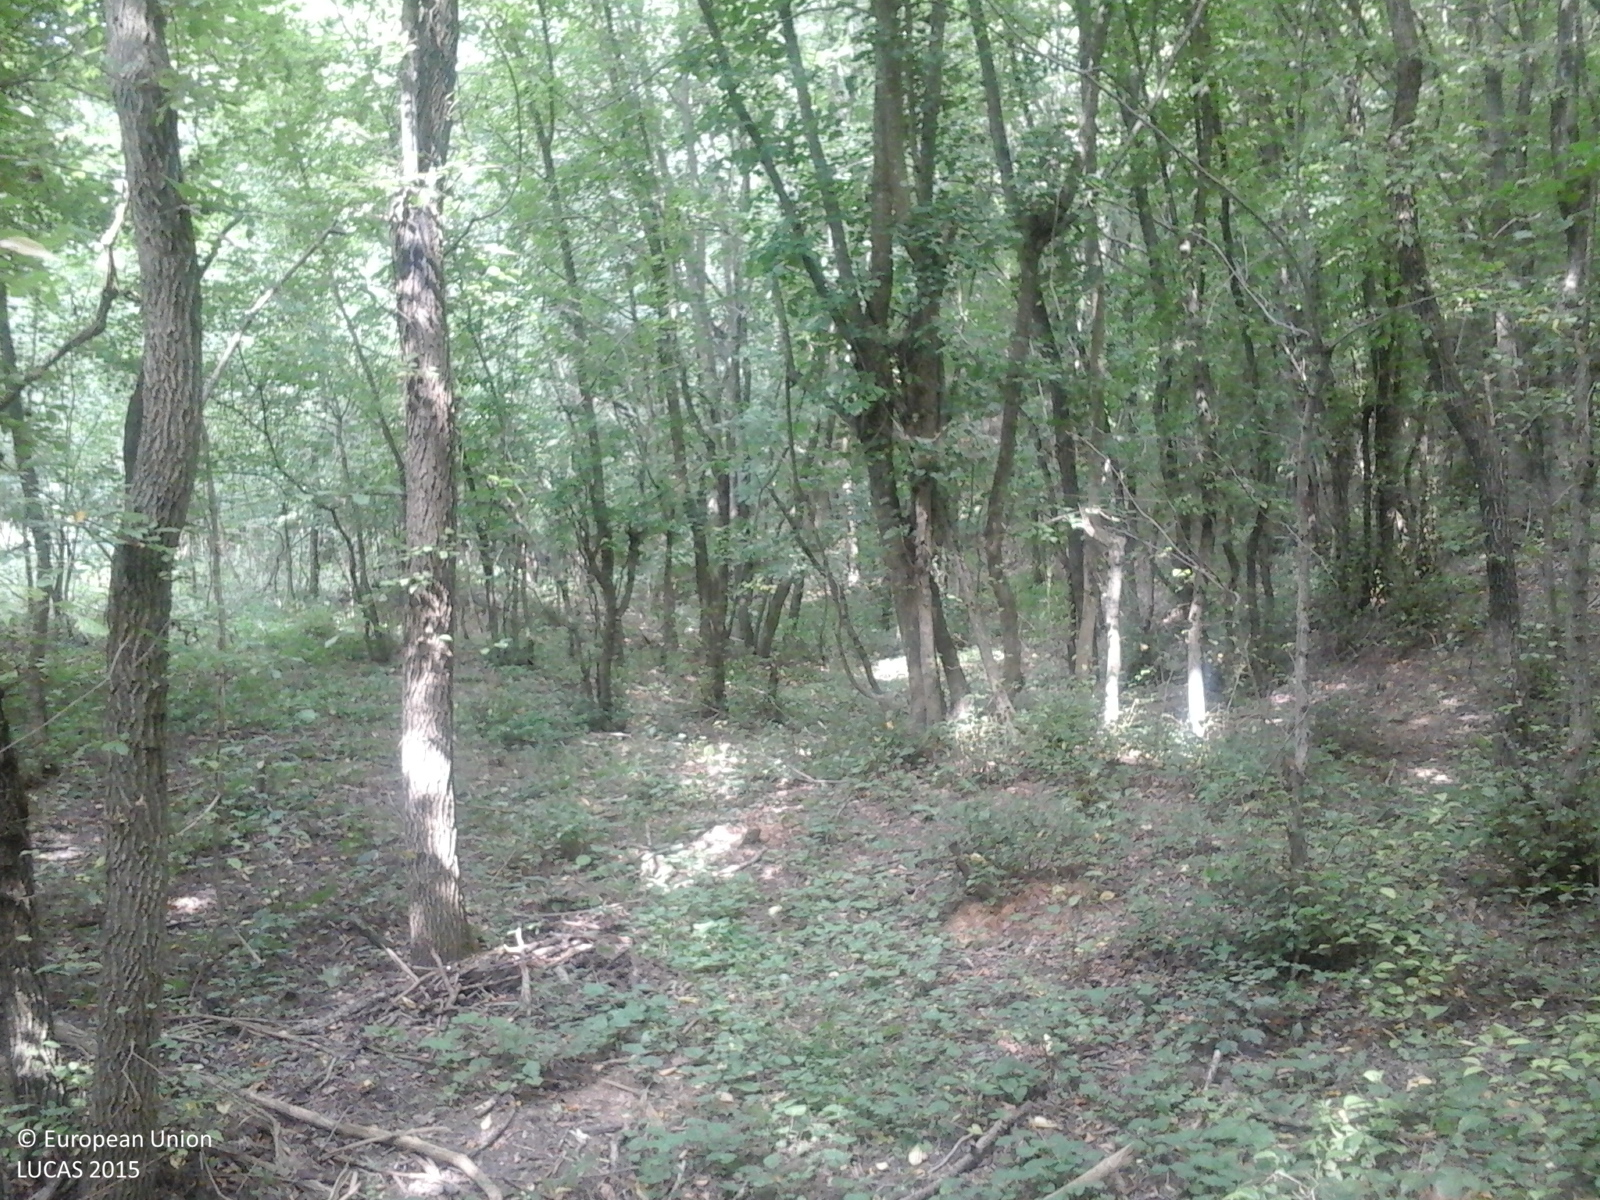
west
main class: Woodland
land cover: Broadleaved woodland
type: mesophytic deciduous forest
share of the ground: > 75 %
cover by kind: broadleaved forest trees 100 %
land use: Forestry
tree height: > 5 m
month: August
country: RO
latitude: 44.8537
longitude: 28.7754
